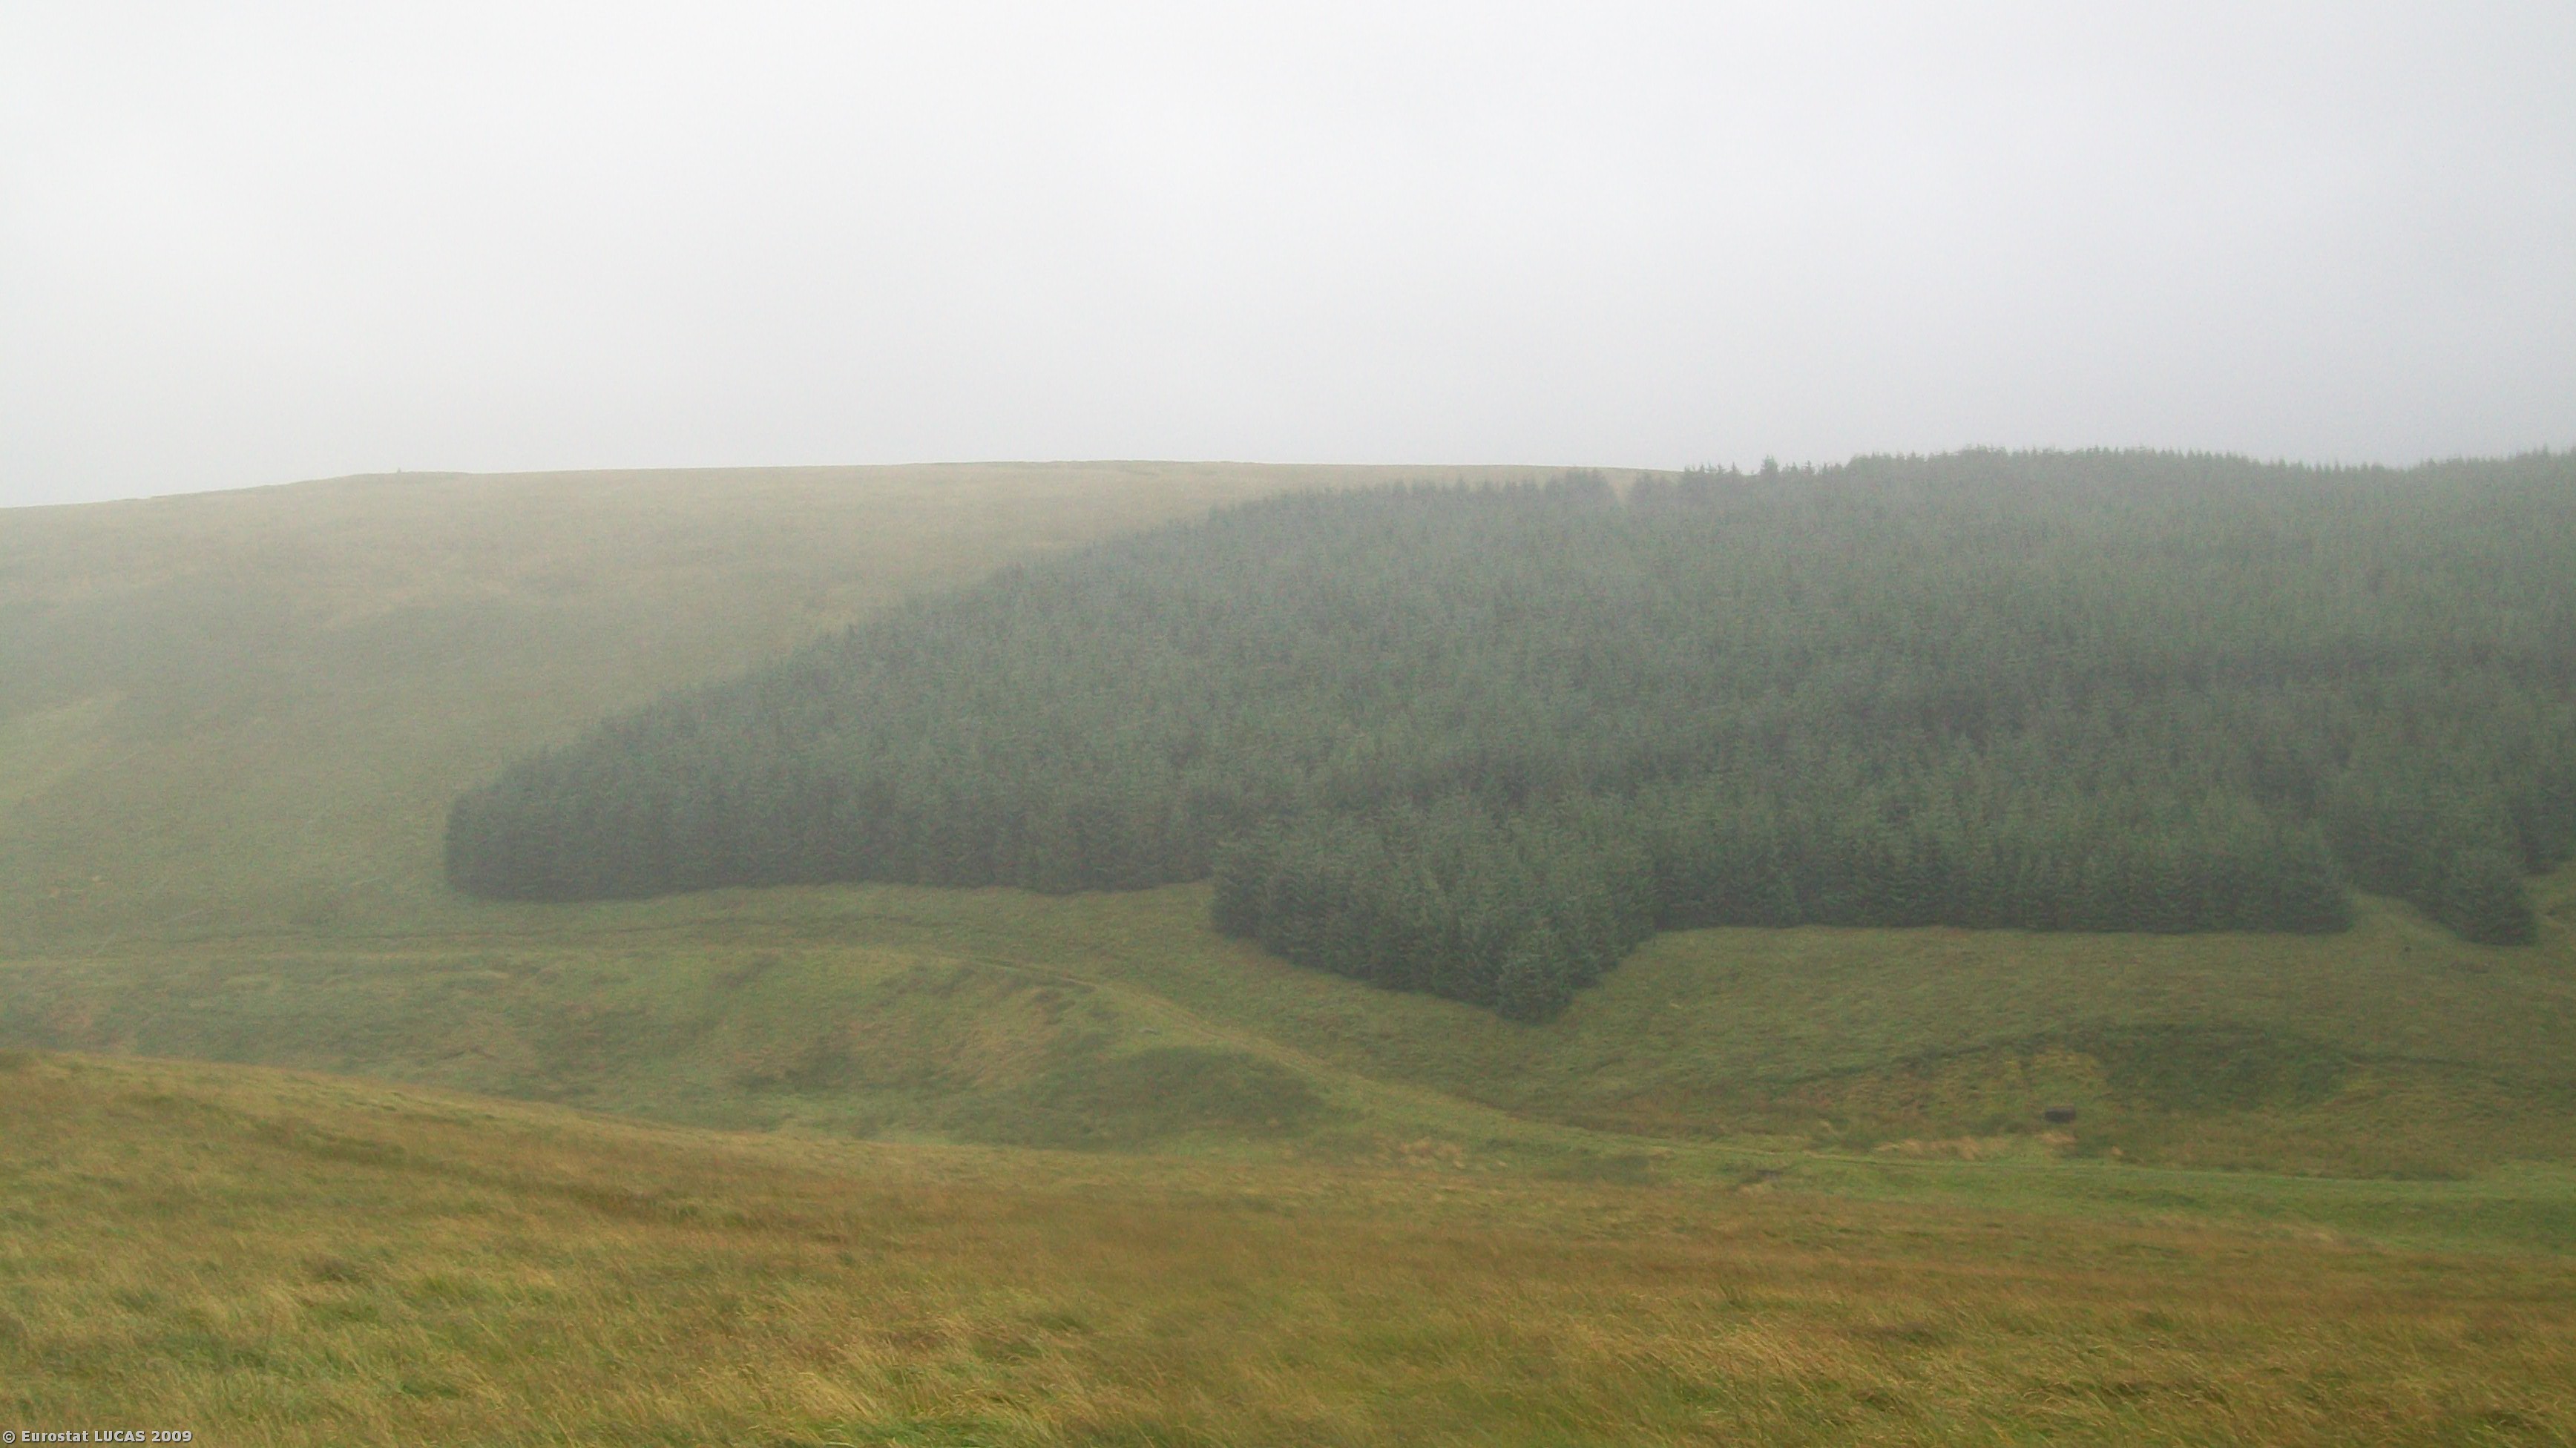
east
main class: Grassland
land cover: Grassland without tree/shrub cover
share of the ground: > 75 %
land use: Agriculture (excluding fallow land and kitchen gardens)
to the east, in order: Grassland without tree/shrub cover; Ditches and canals; Tracks; Grassland without tree/shrub cover; Tracks; Grassland without tree/shrub cover; Fences; Broadleaved woodland; Rivers and streams; Grassland without tree/shrub cover; Tracks; Grass margins; Ditches and canals
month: August
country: GB
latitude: 55.4723
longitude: -3.4779
